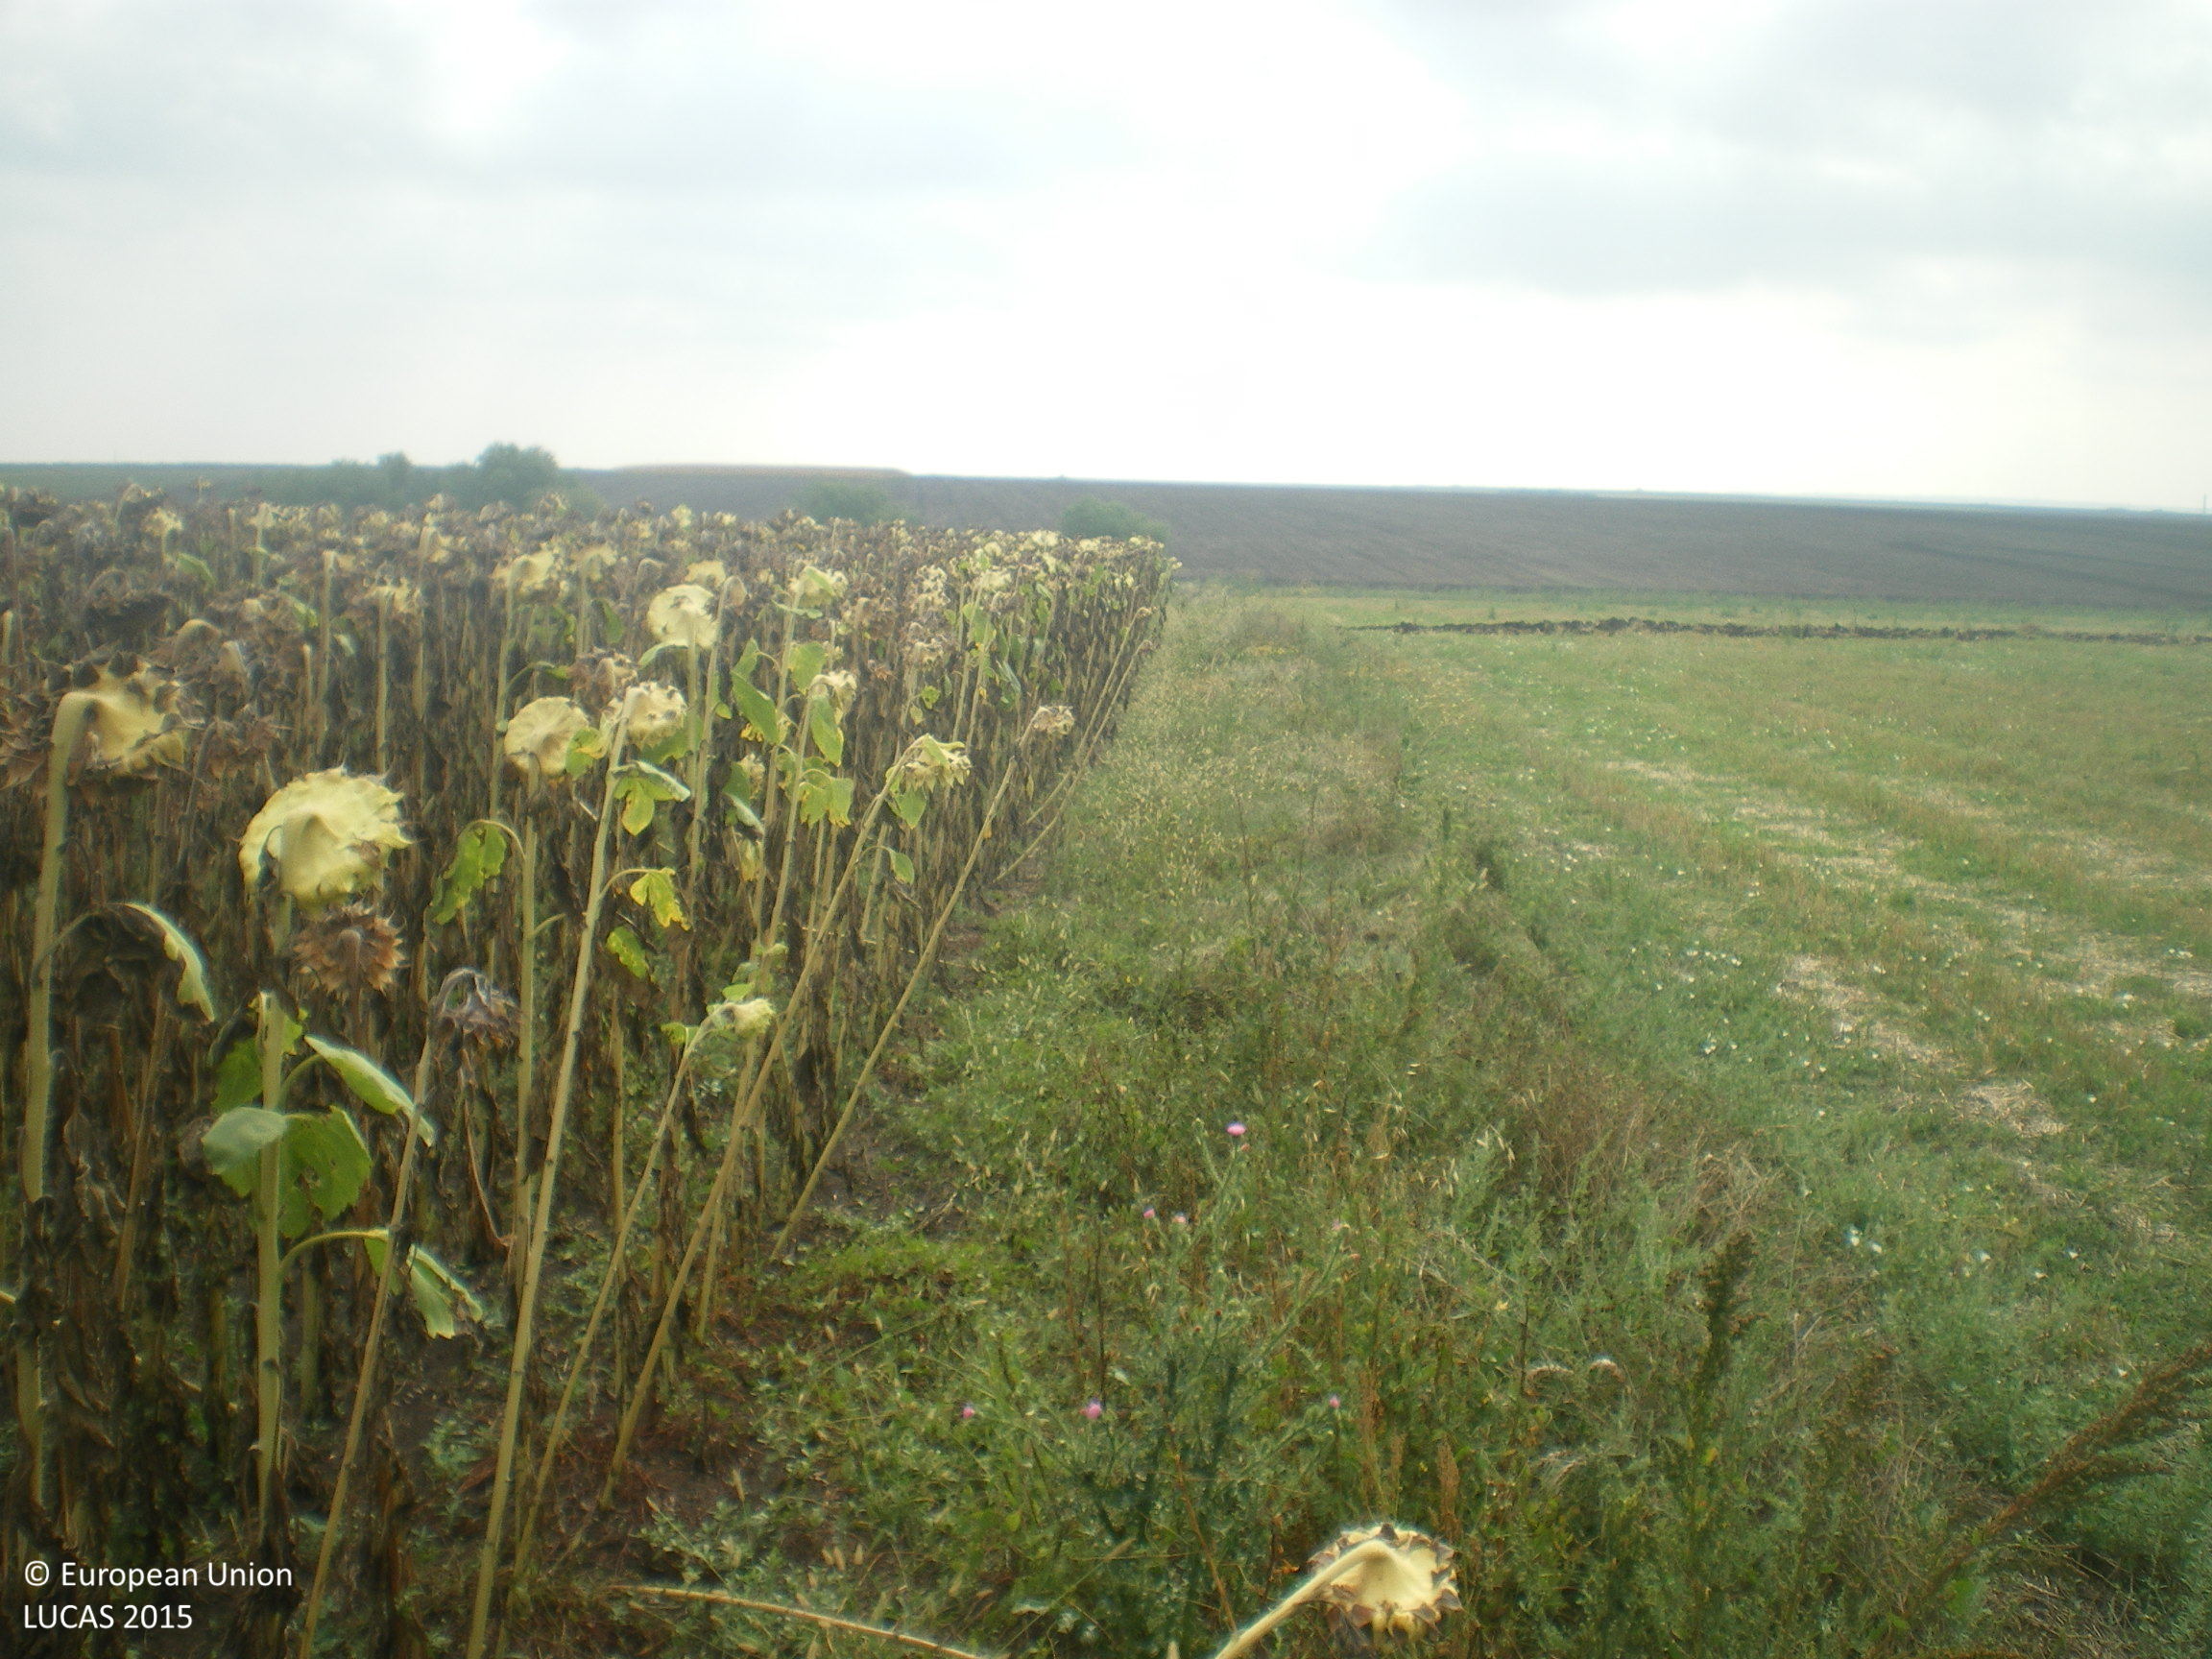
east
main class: Cropland
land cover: Sunflower
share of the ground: > 75 %
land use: Agriculture (excluding fallow land and kitchen gardens)
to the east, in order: Sunflower; Tracks; Ditches and canals; Broadleaved woodland; Grassland without tree/shrub cover; Tracks; Sunflower
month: August
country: BG
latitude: 42.3236
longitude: 25.9122
